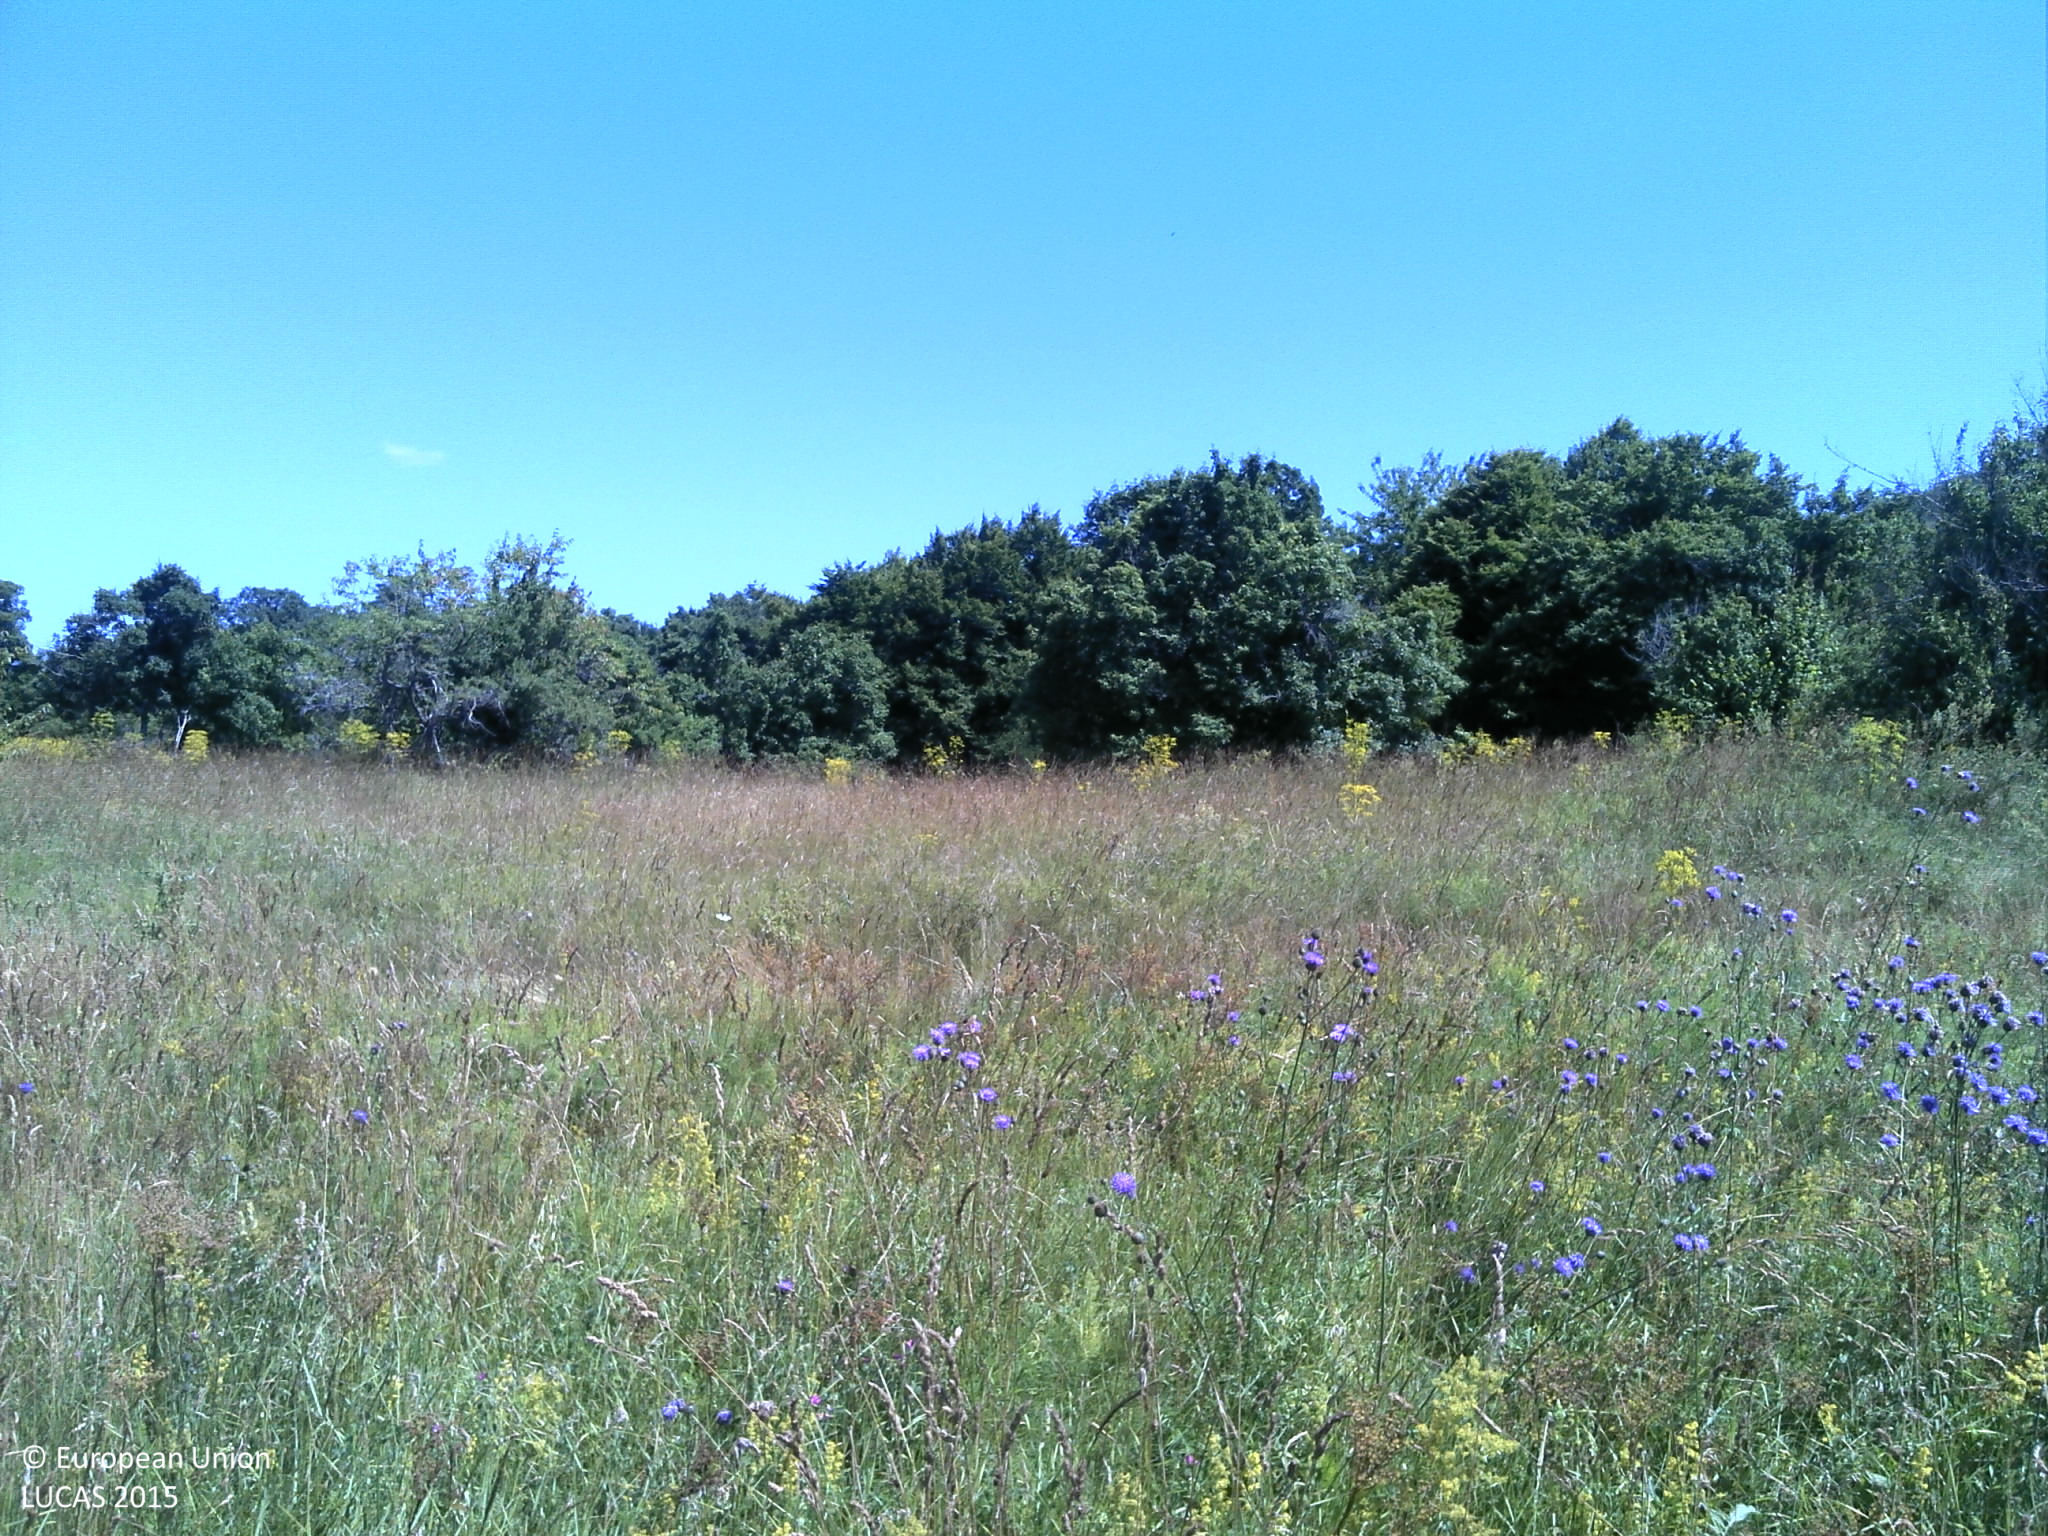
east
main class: Grassland
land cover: Grassland without tree/shrub cover
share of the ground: > 75 %
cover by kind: herbaceous plants 95 %, shrubs 5 %
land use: Semi-natural and natural areas not in use
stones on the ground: < 10 %
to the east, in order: Grassland without tree/shrub cover; Tracks; Grassland with sparse tree/shrub cover; Broadleaved woodland; Grassland with sparse tree/shrub cover; Broadleaved woodland; Grassland with sparse tree/shrub cover
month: July
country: HR
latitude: 44.9247
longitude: 15.2014
